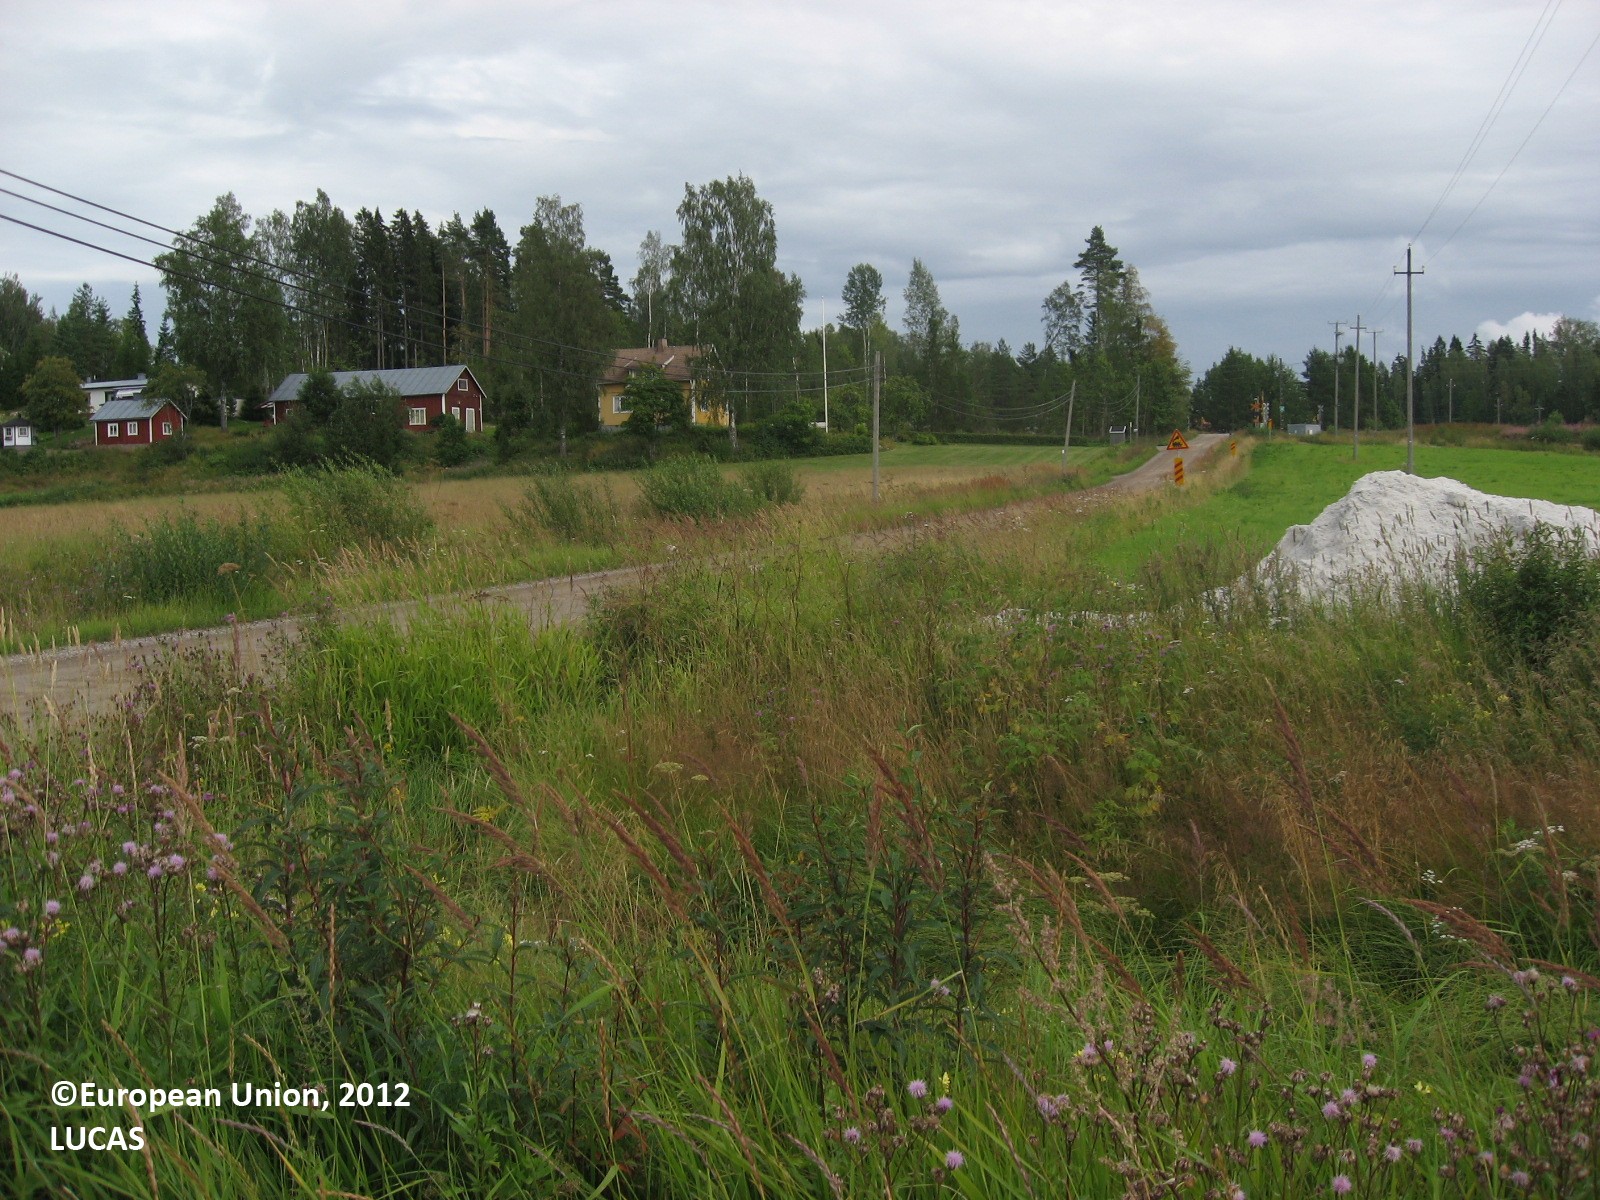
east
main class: Cropland
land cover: Temporary grasslands
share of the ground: > 75 %
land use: Agriculture (excluding fallow land and kitchen gardens)
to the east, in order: Temporary grasslands; Grass margins; Rivers and streams; Grass margins; Temporary grasslands; Electric lines; Temporary grasslands; Grass margins; Ditches and canals; Grass margins; Paved roads, cycling and walking lanes
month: August
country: FI
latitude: 60.3858
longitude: 25.3102
